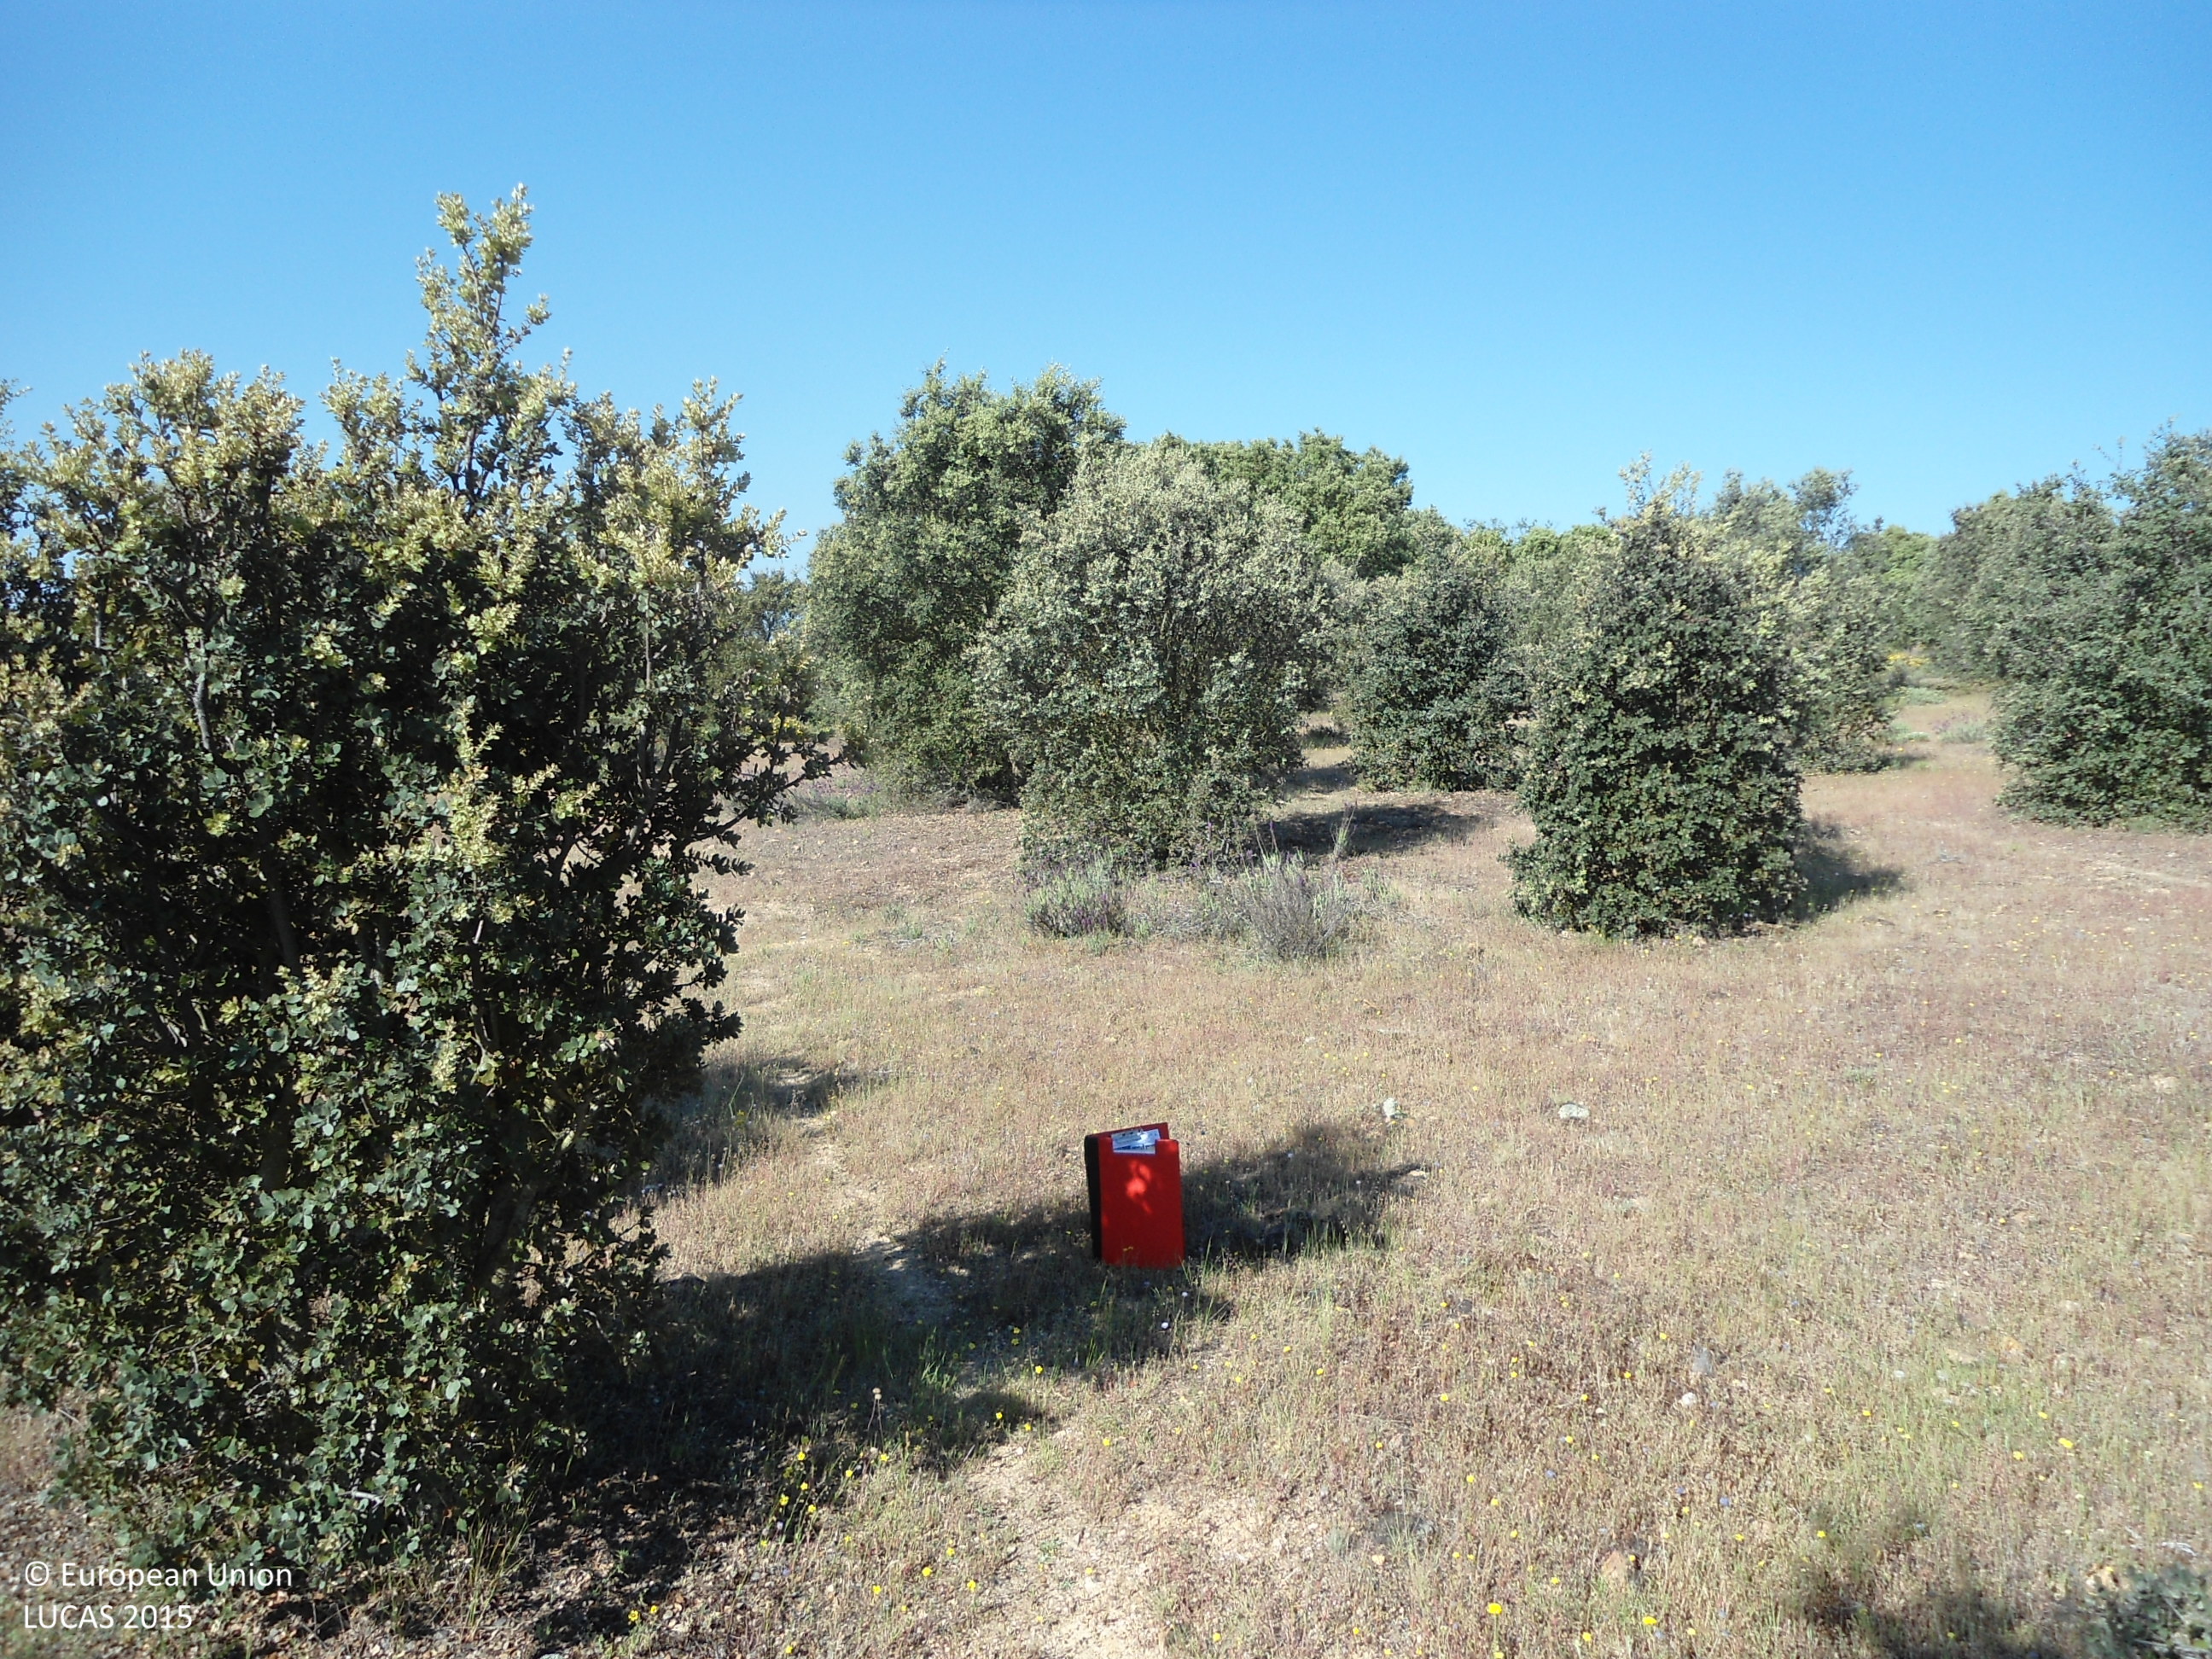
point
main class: Grassland
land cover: Grassland with sparse tree/shrub cover
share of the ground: 50 - 75 %
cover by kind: herbaceous plants 85 %, shrubs 10 %, broadleaved forest trees 5 %
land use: Agriculture (excluding fallow land and kitchen gardens)
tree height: < 5 m
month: June
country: ES
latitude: 42.0335
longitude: -6.2297
